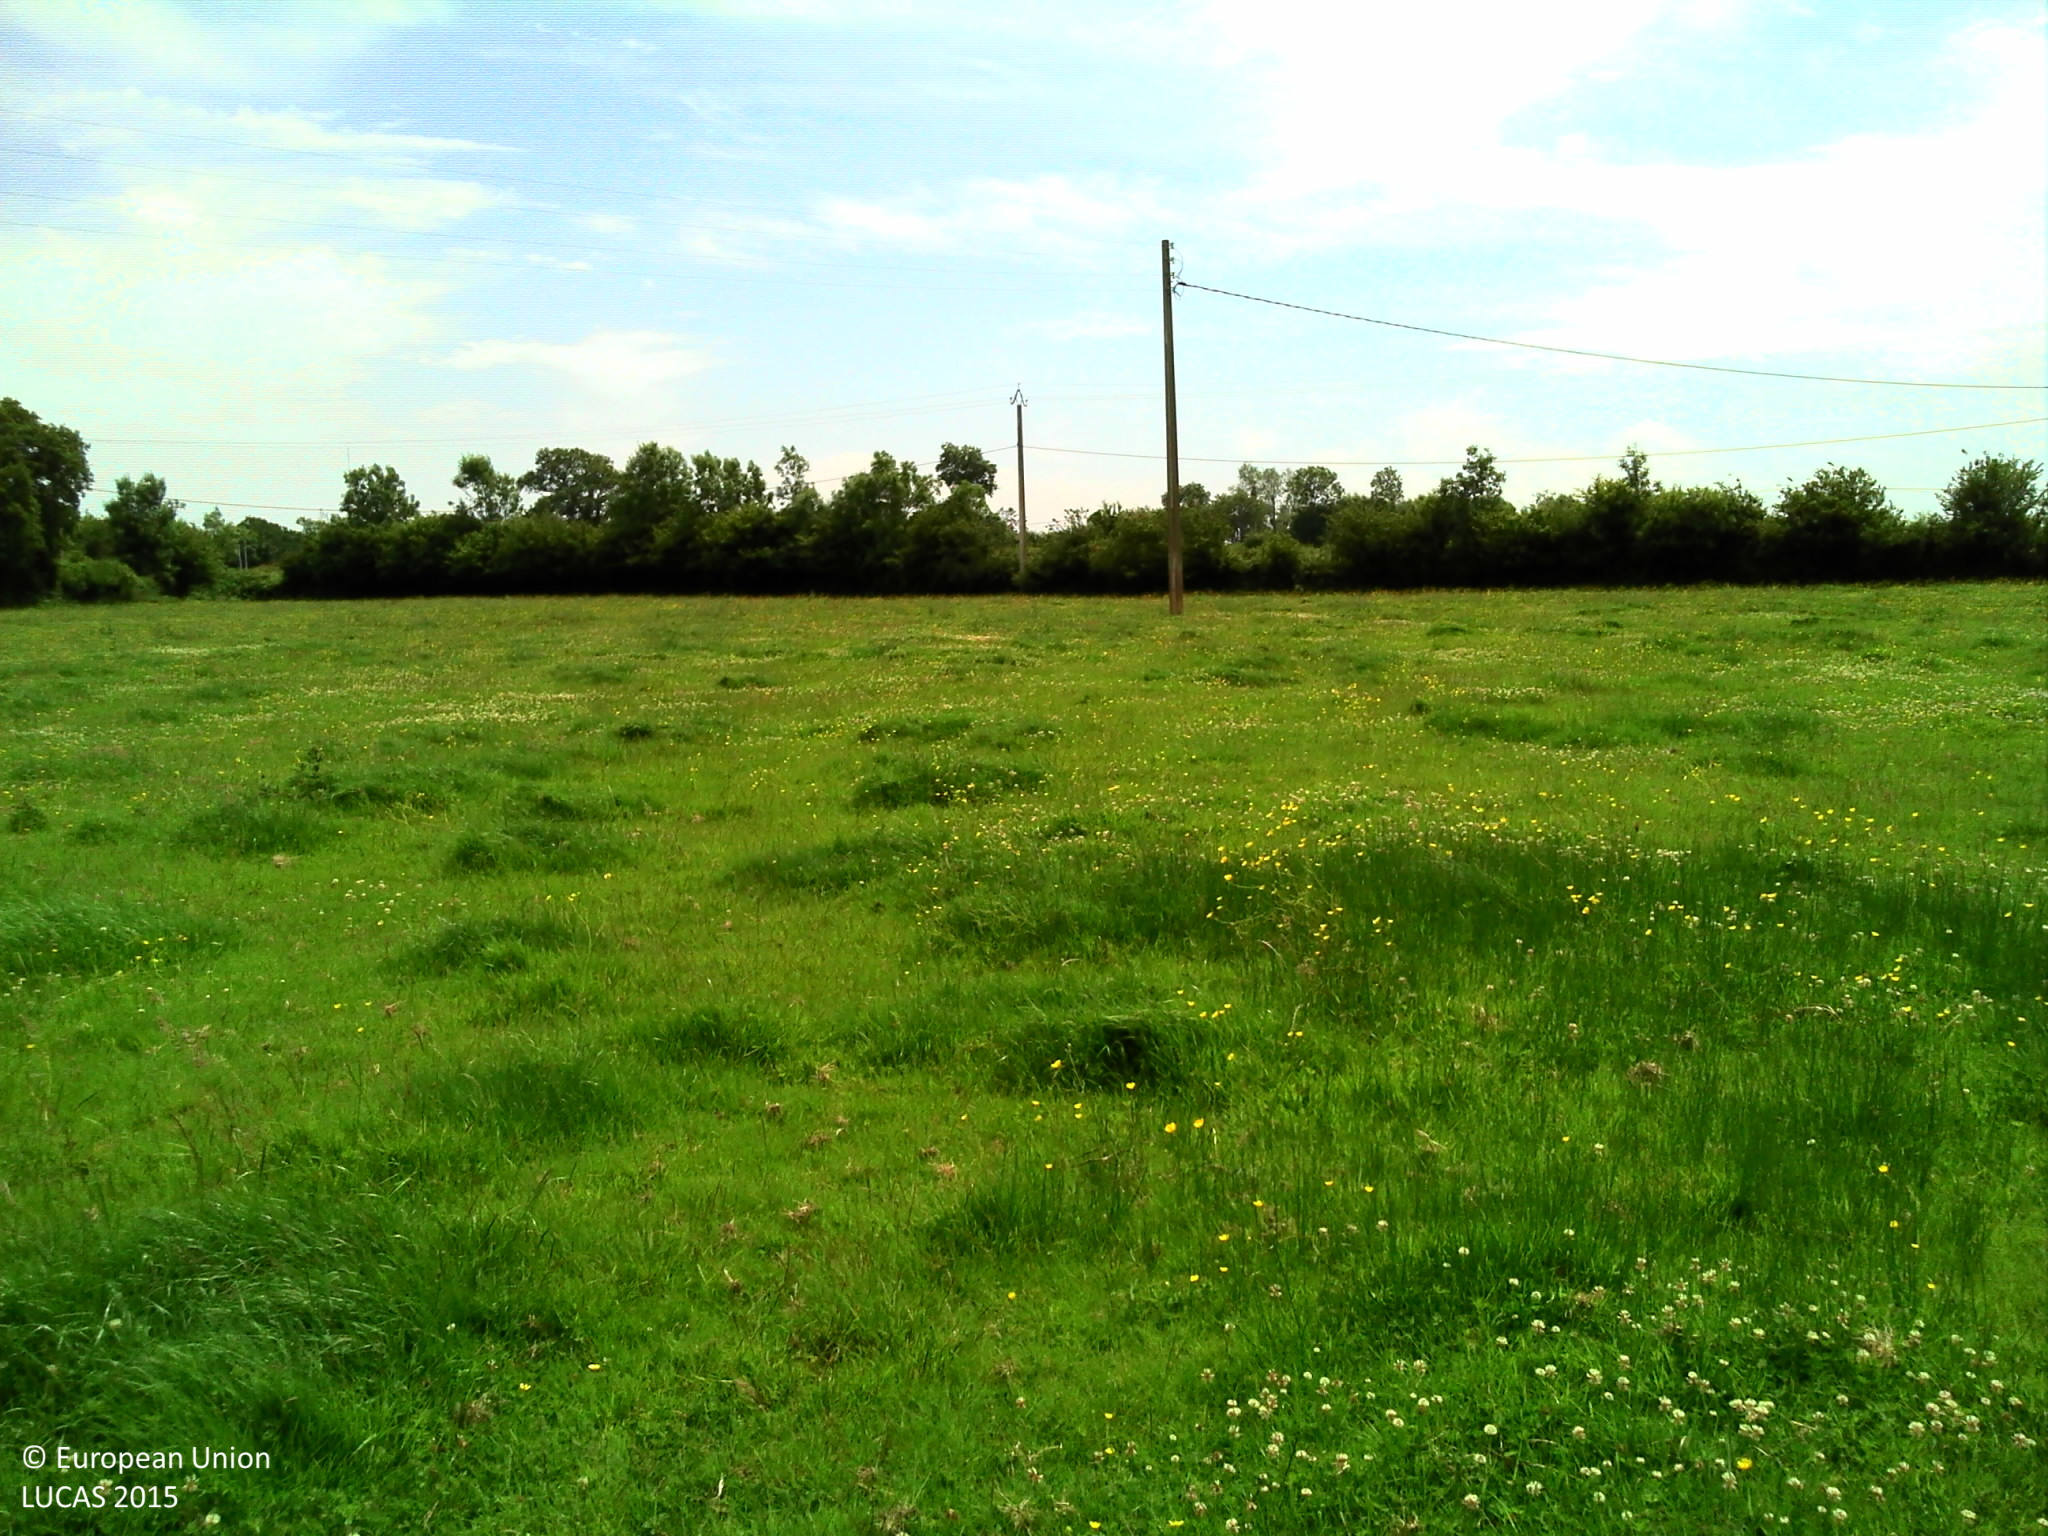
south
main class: Grassland
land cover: Grassland without tree/shrub cover
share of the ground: > 75 %
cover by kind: herbaceous plants 100 %
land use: Agriculture (excluding fallow land and kitchen gardens)
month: June
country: FR
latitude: 49.1697
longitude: -1.4457
